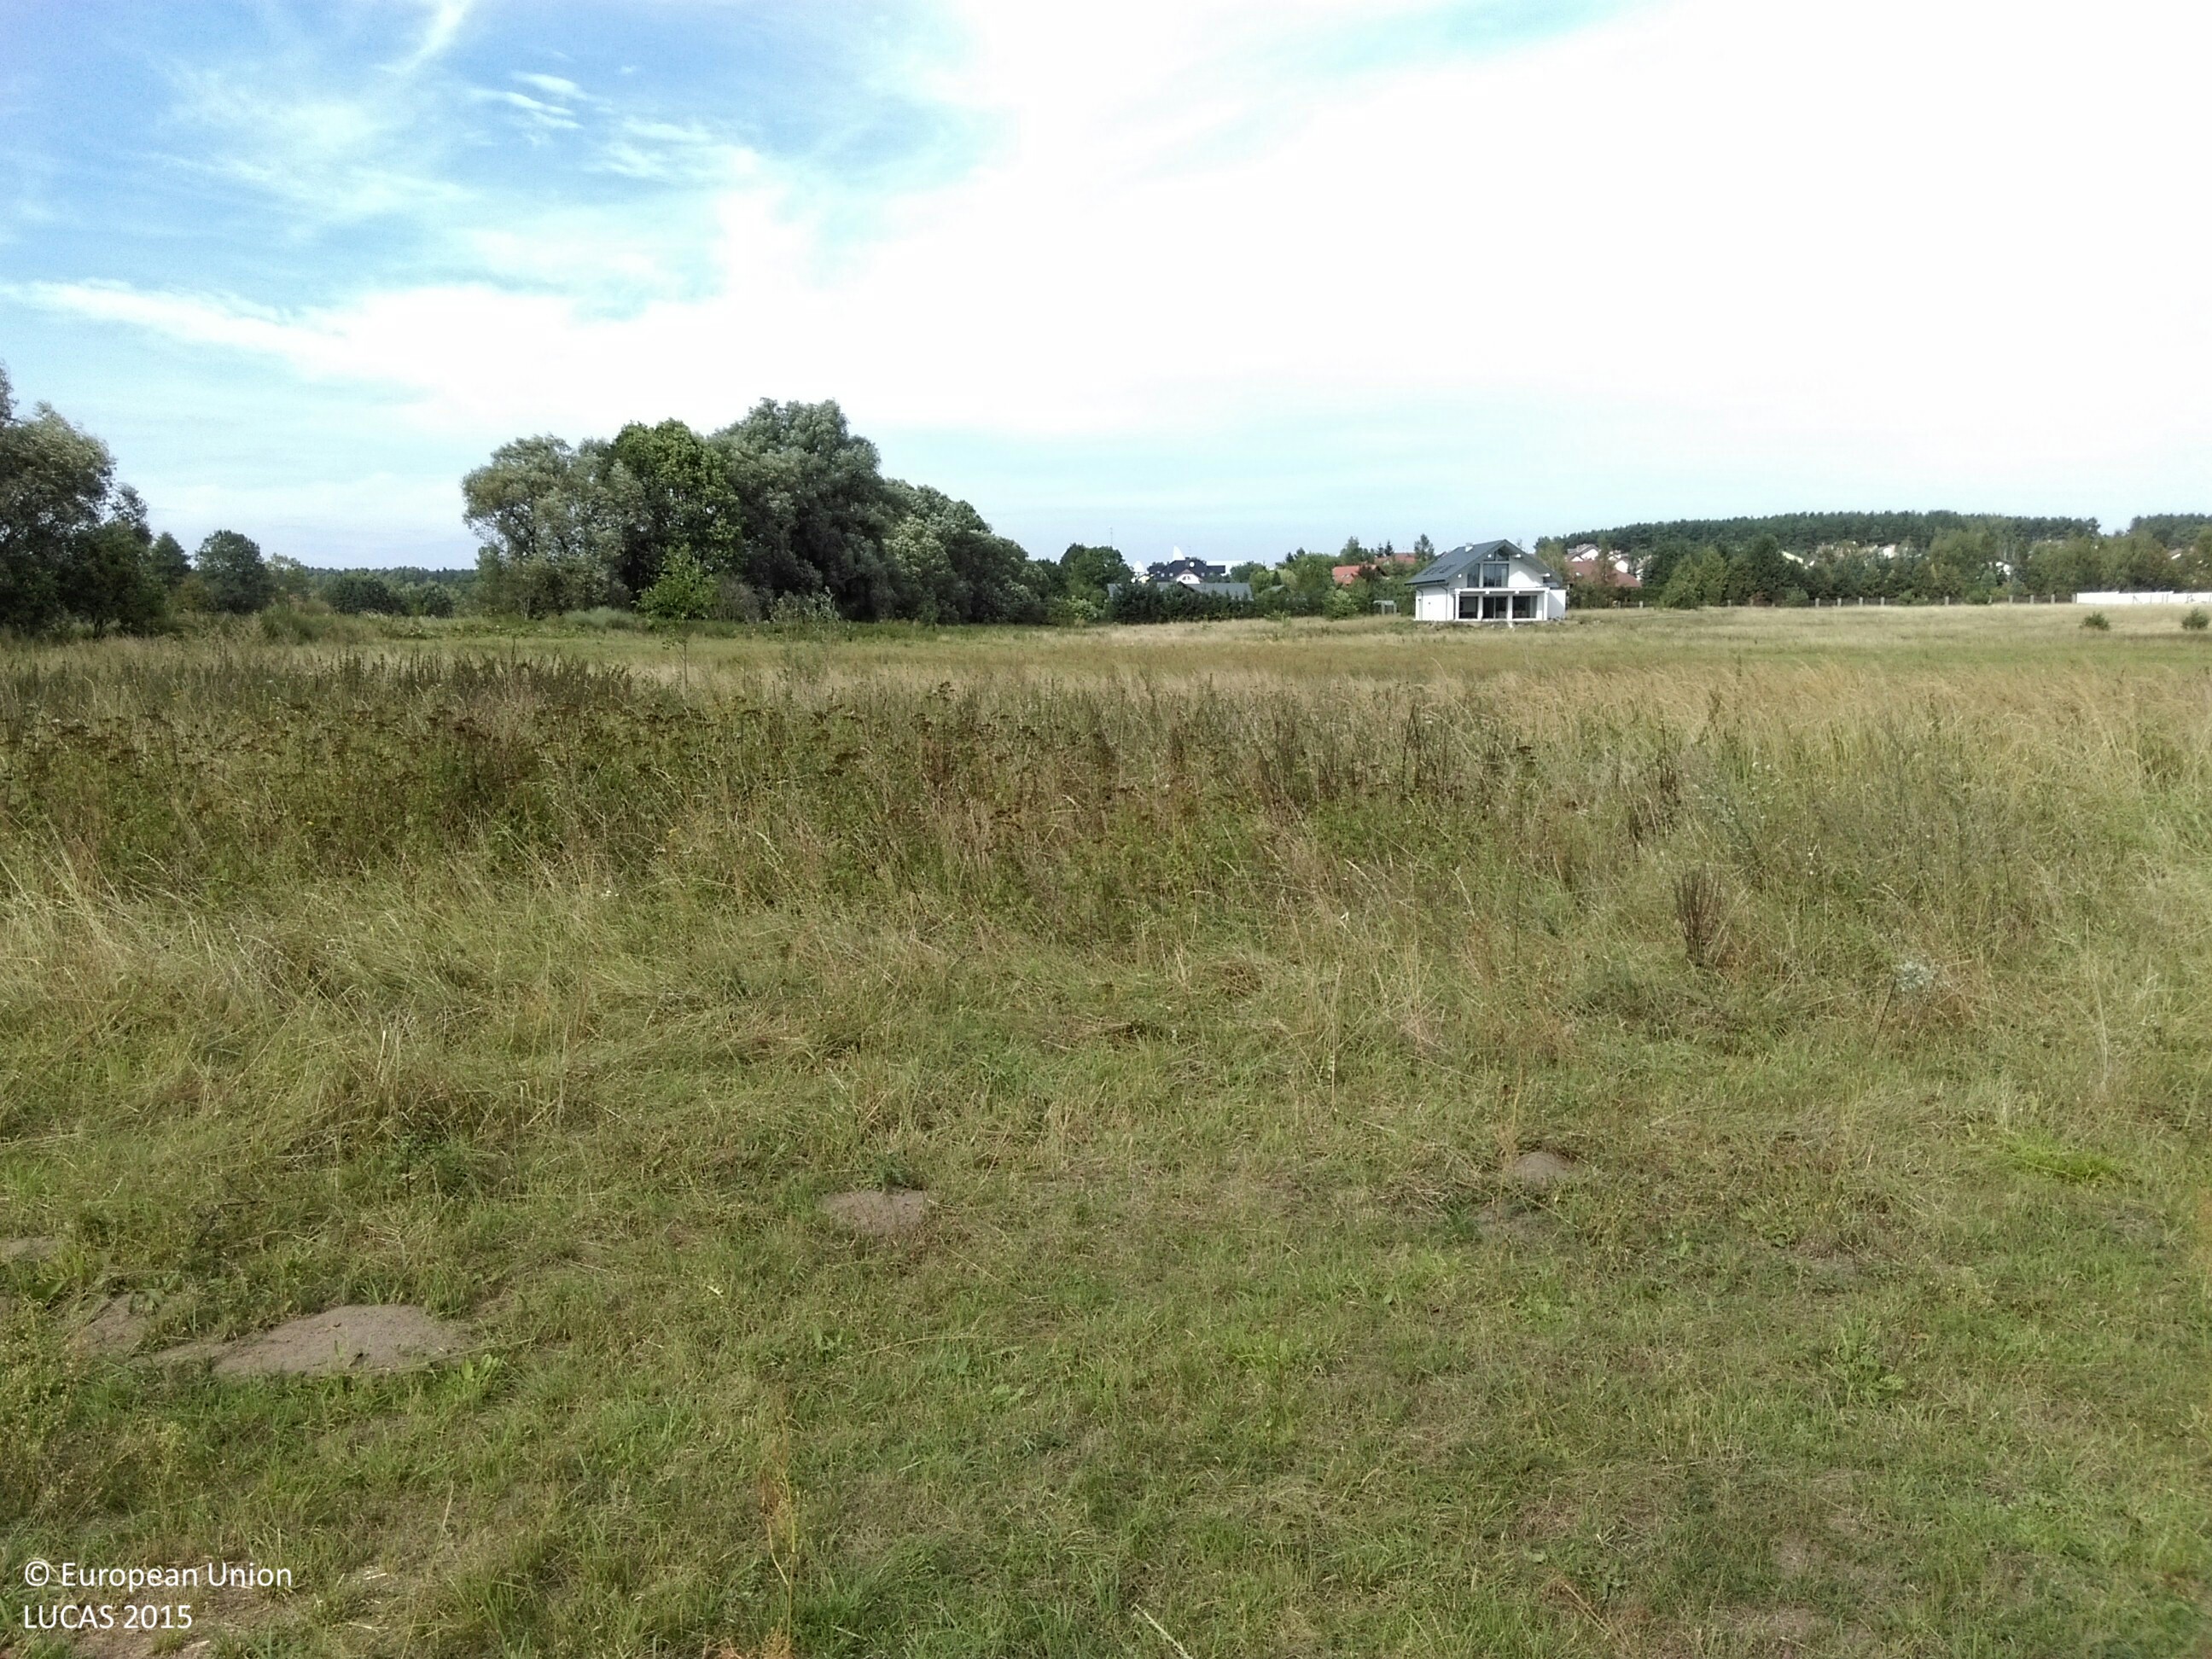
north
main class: Grassland
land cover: Grassland without tree/shrub cover
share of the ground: > 75 %
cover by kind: herbaceous plants 100 %
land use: Agriculture (excluding fallow land and kitchen gardens)
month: September
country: PL
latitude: 51.8864
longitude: 15.5689
